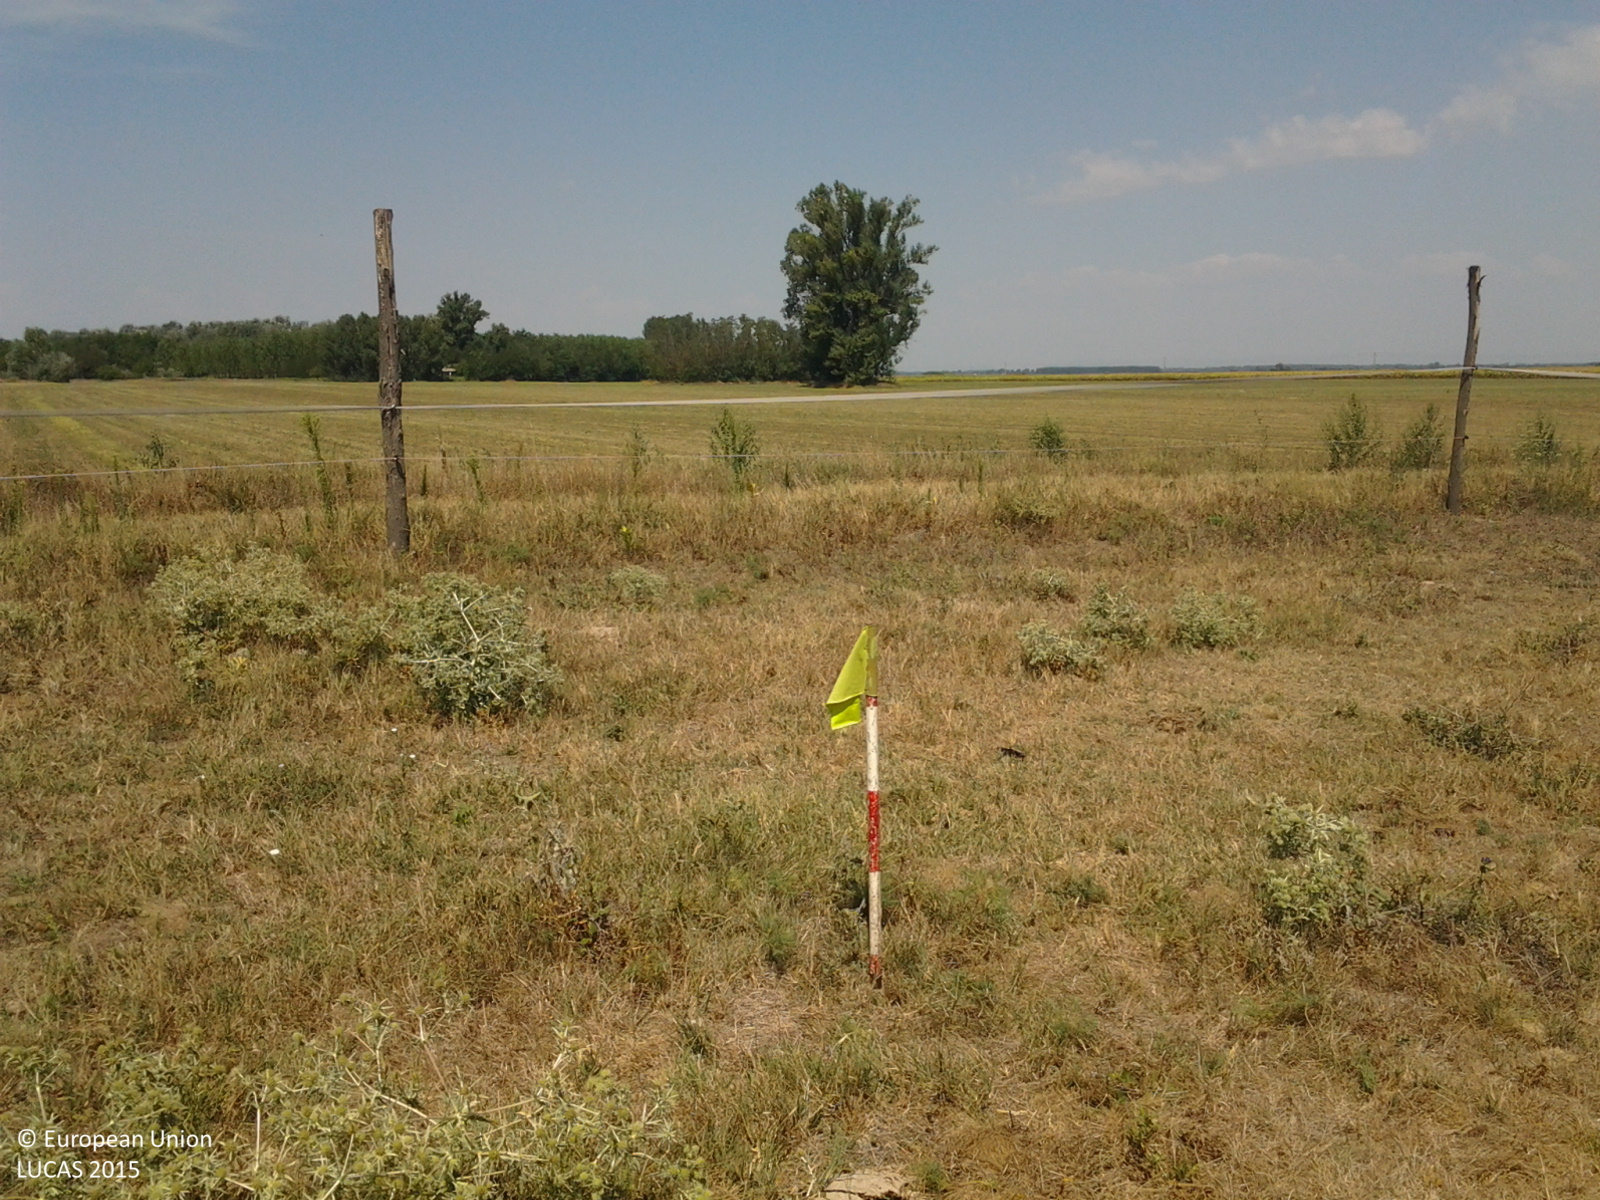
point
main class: Grassland
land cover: Grassland without tree/shrub cover
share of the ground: > 75 %
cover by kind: herbaceous plants 100 %
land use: Agriculture (excluding fallow land and kitchen gardens)
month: August
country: HU
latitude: 47.3883
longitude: 19.7867
